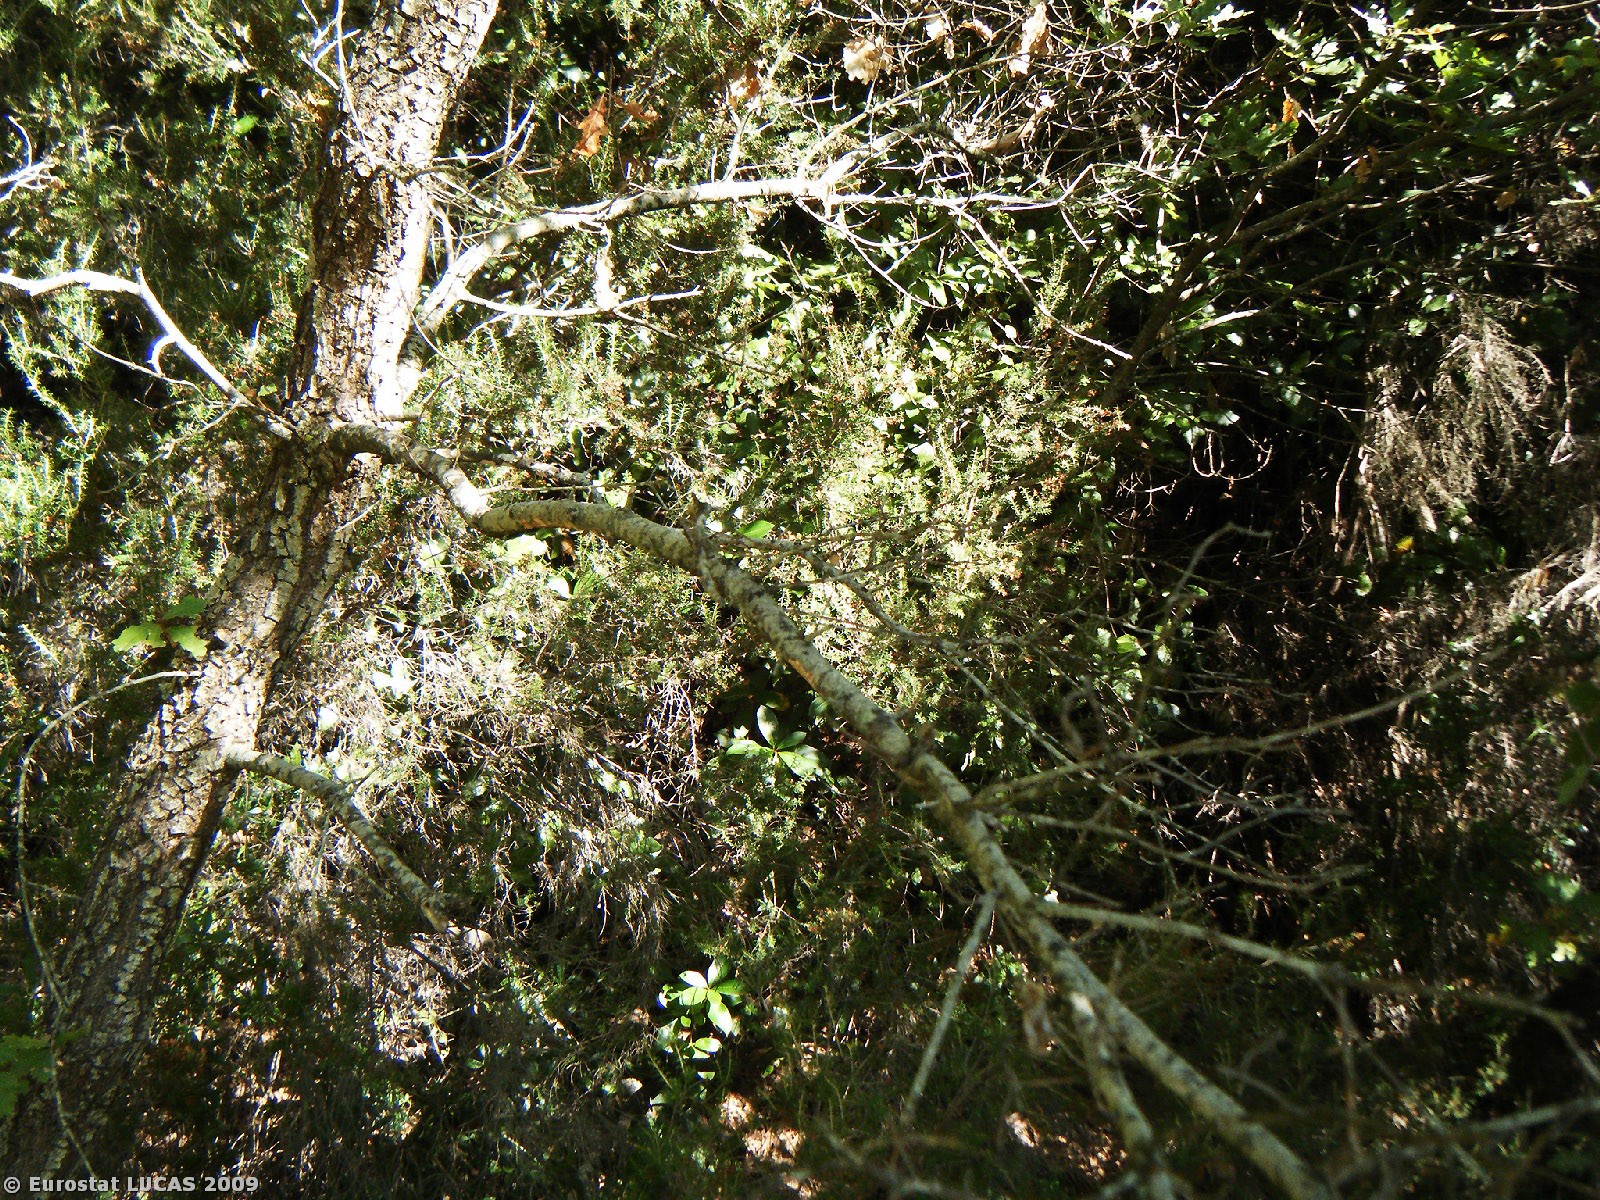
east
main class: Woodland
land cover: Broadleaved woodland
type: thermophilous deciduous forest
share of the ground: > 75 %
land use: Forestry
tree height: > 5 m
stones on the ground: > 50 %
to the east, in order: Broadleaved woodland; Tracks; Shrubland without tree cover; Tracks; Shrubland with sparse tree cover; Shrubland without tree cover; Coniferous woodland
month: October
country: GR
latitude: 37.3047
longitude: 22.3580
